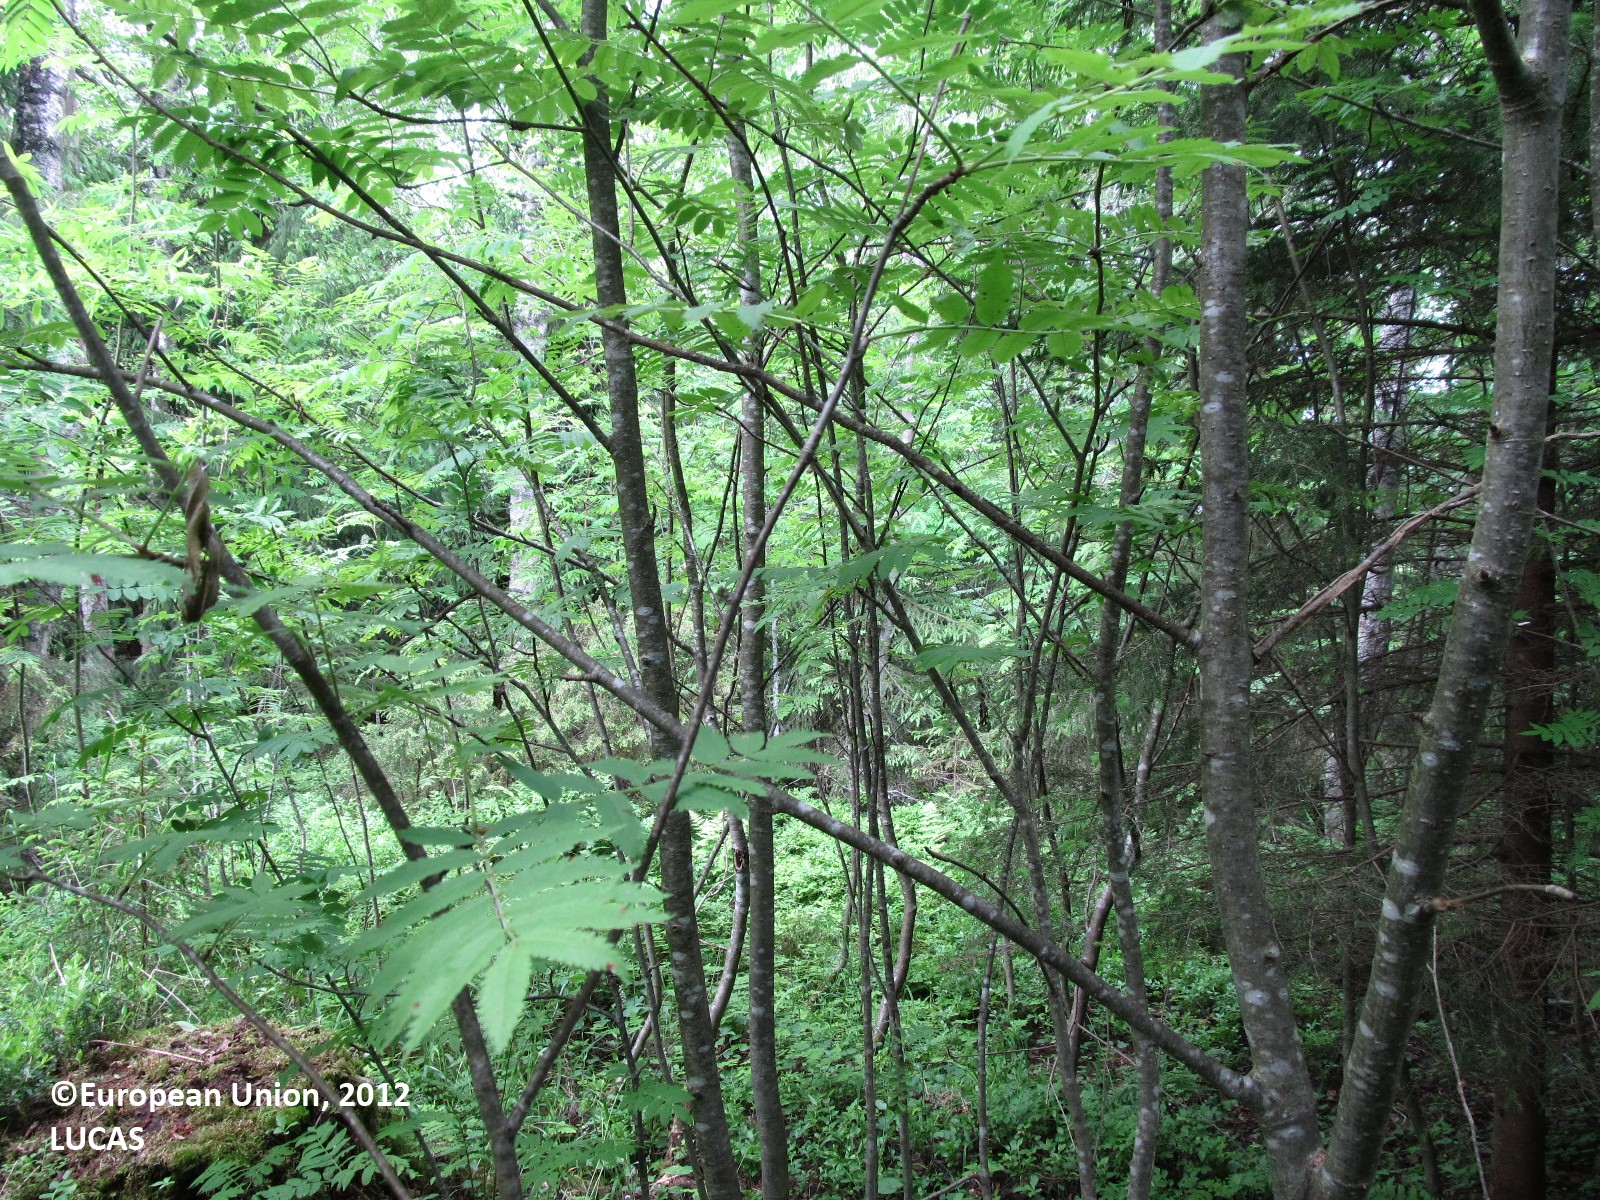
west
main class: Woodland
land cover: Spruce dominated mixed woodland
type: boreal forest
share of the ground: 50 - 75 %
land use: Forestry
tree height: > 5 m
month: June
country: FI
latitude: 63.2143
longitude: 27.7701
